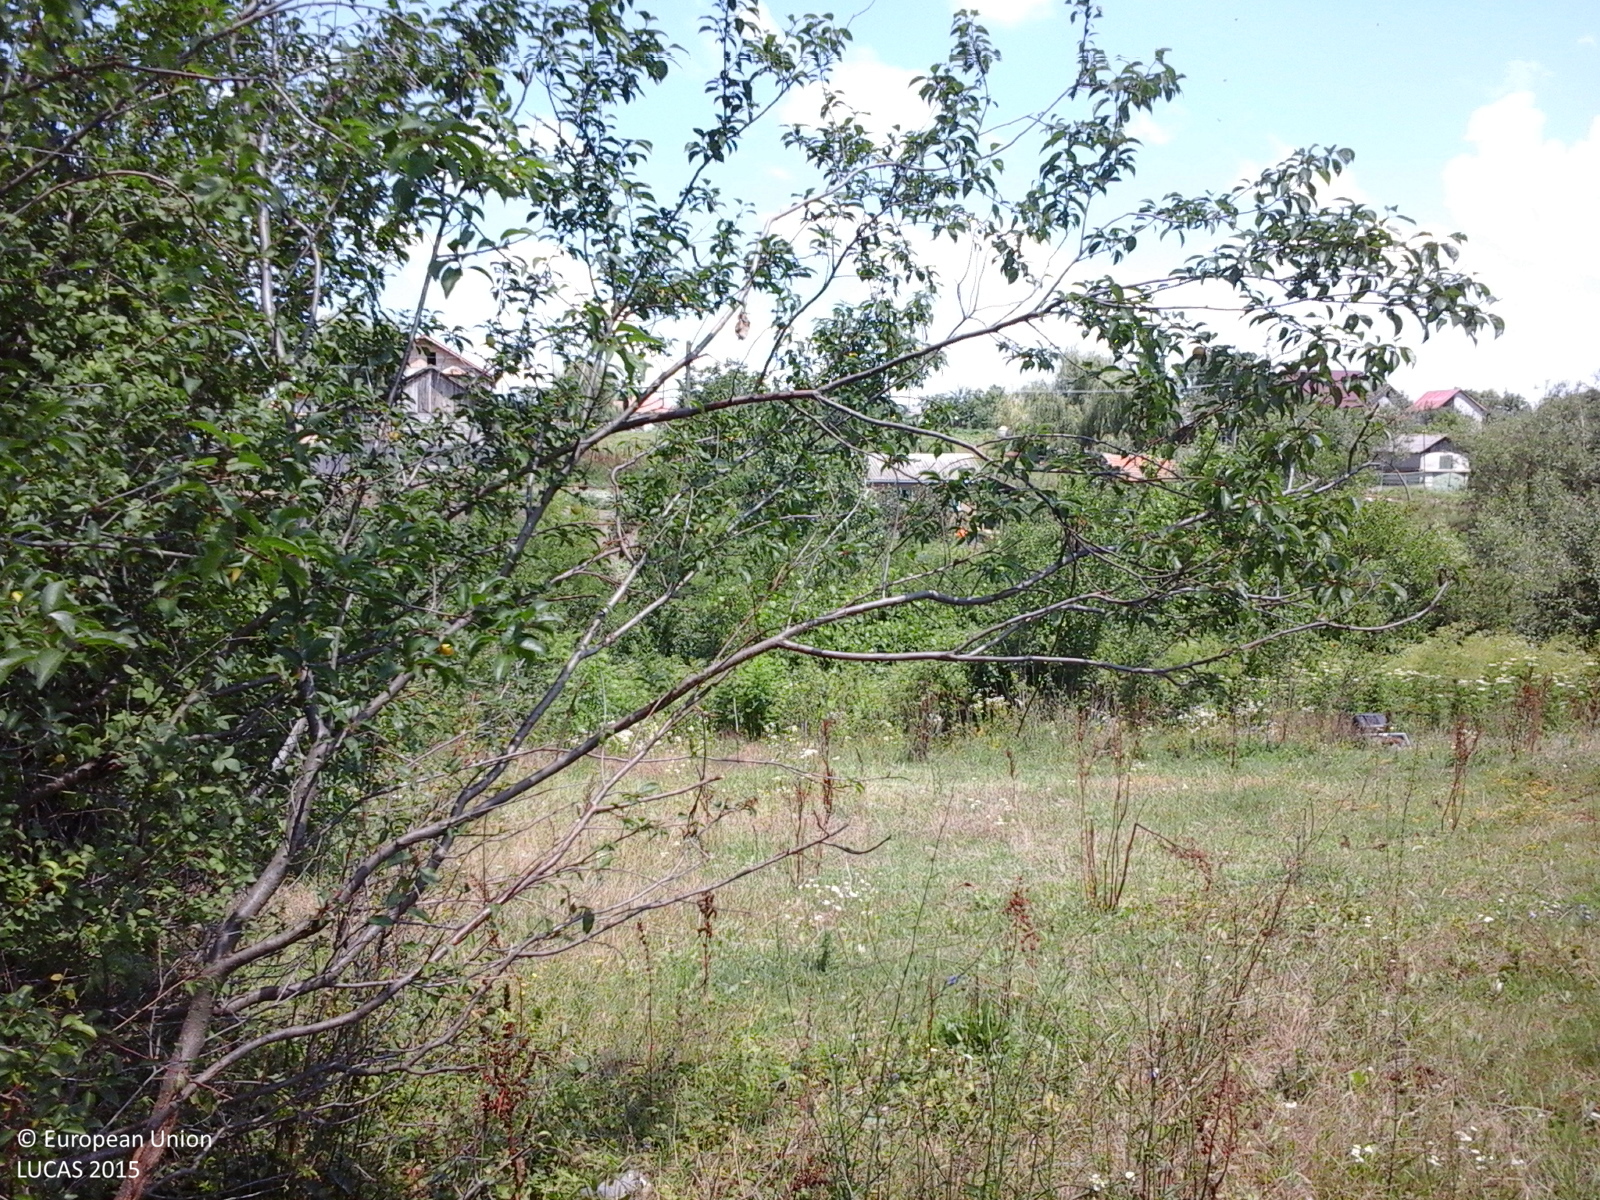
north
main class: Cropland
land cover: Vineyards
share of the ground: 50 - 75 %
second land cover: Grassland without tree/shrub cover
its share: 25 - 50 %
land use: Agriculture (excluding fallow land and kitchen gardens)
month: July
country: RO
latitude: 44.2366
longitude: 24.7861
